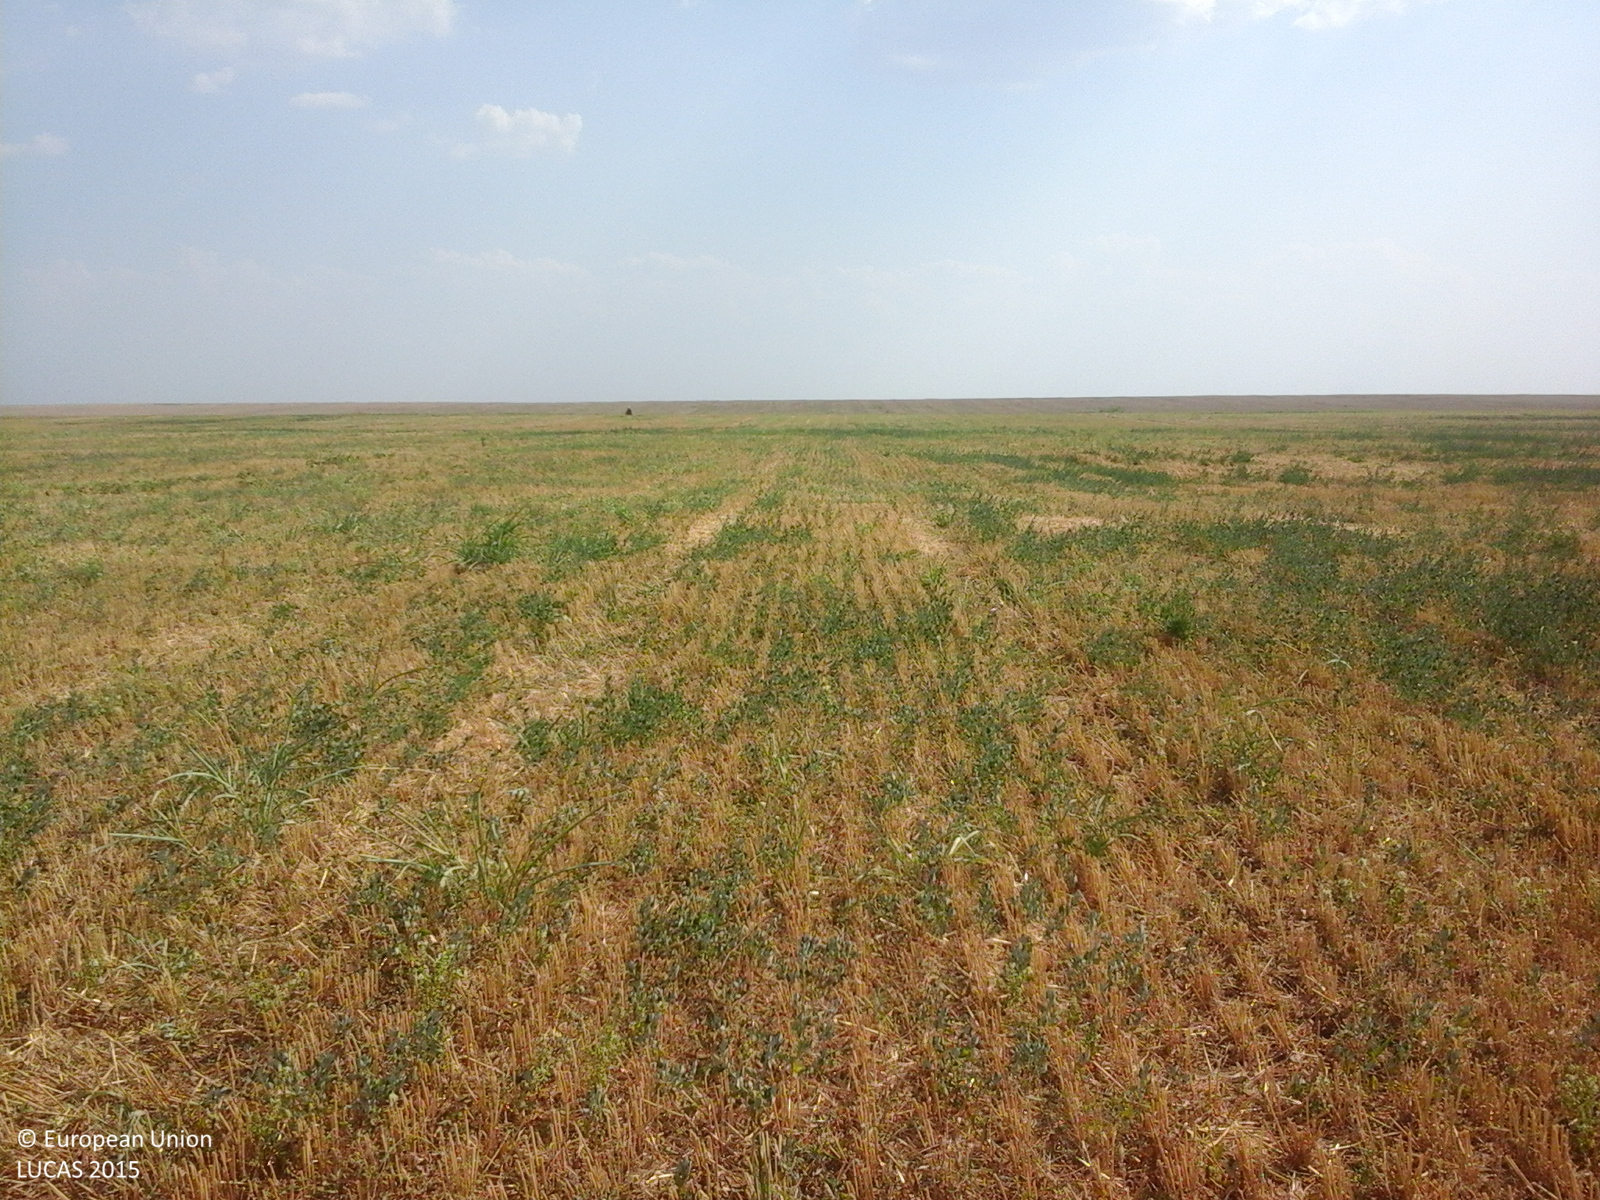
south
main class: Cropland
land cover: Common wheat
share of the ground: > 75 %
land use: Agriculture (excluding fallow land and kitchen gardens)
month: August
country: RO
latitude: 44.1004
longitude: 23.0978
